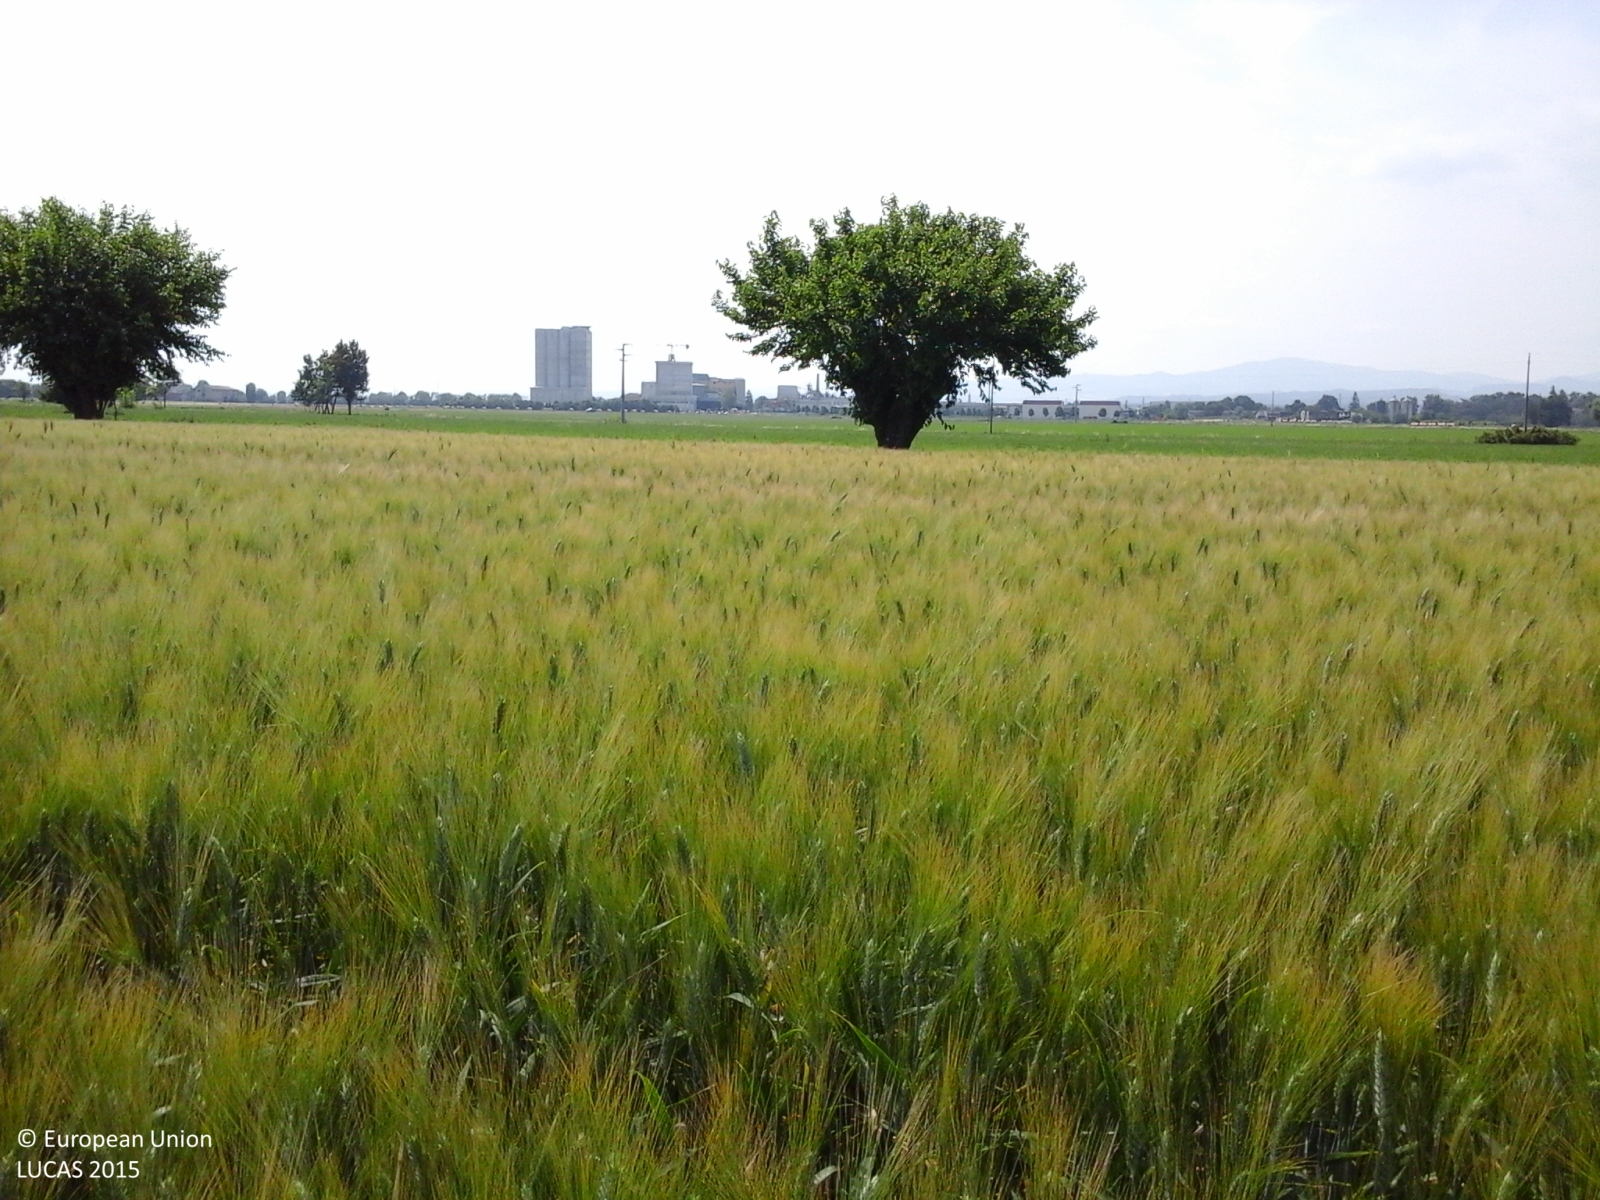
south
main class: Cropland
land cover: Common wheat
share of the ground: > 75 %
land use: Agriculture (excluding fallow land and kitchen gardens)
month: May
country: IT
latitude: 44.7831
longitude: 10.2144
